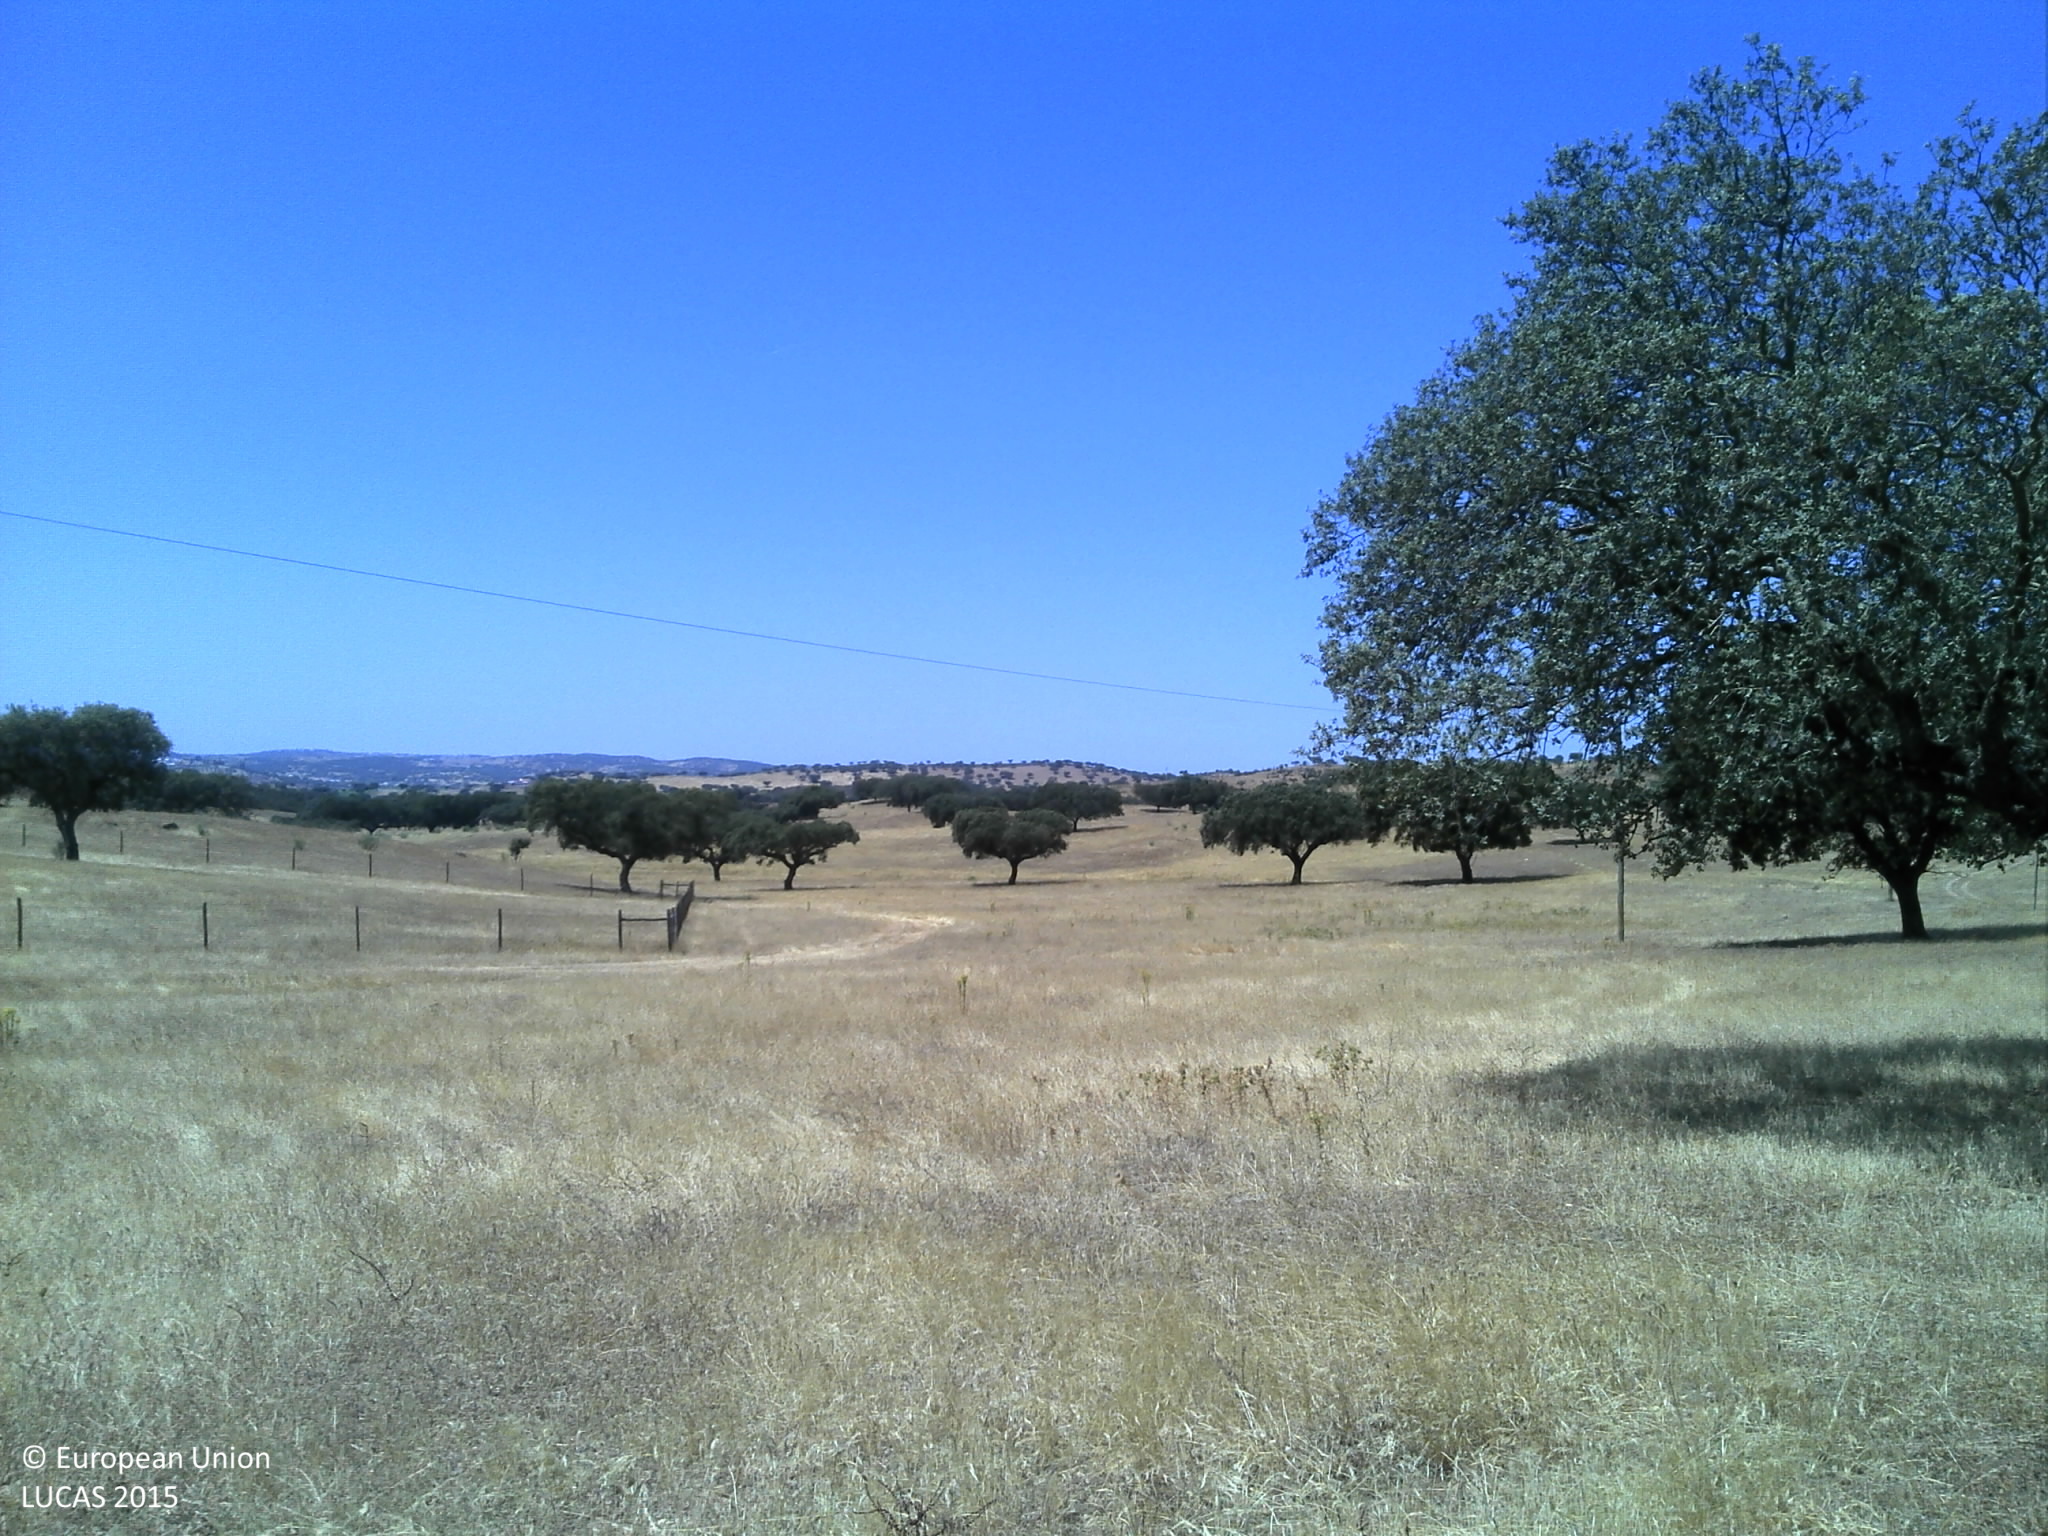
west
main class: Grassland
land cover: Grassland without tree/shrub cover
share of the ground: 10 - 25 %
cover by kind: unconsolidated bare surface 90 %, herbaceous plants 10 %
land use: Agriculture (excluding fallow land and kitchen gardens)
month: July
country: PT
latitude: 38.6496
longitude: -7.3670
